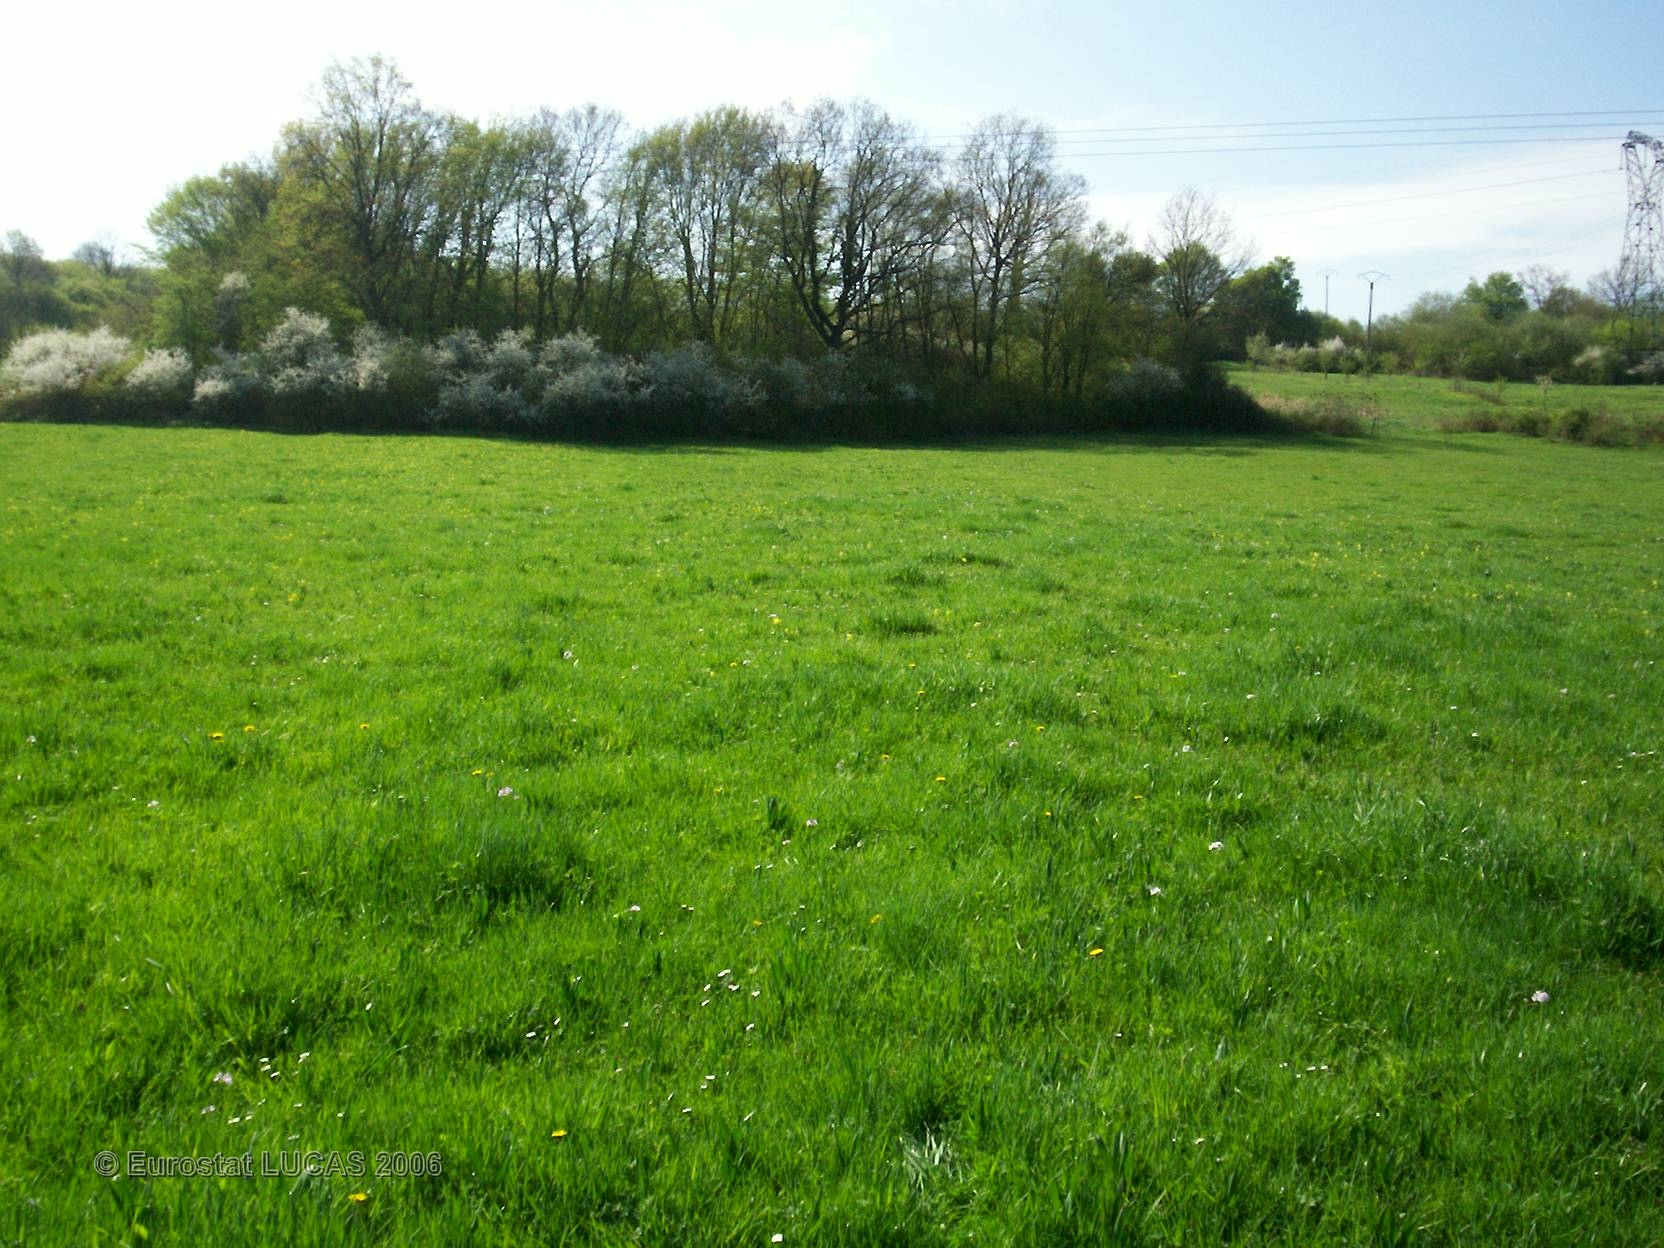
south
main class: Grassland
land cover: Grassland without tree/shrub cover
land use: Agriculture (excluding fallow land and kitchen gardens)
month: April
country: FR
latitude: 49.0582
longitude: 6.7570
